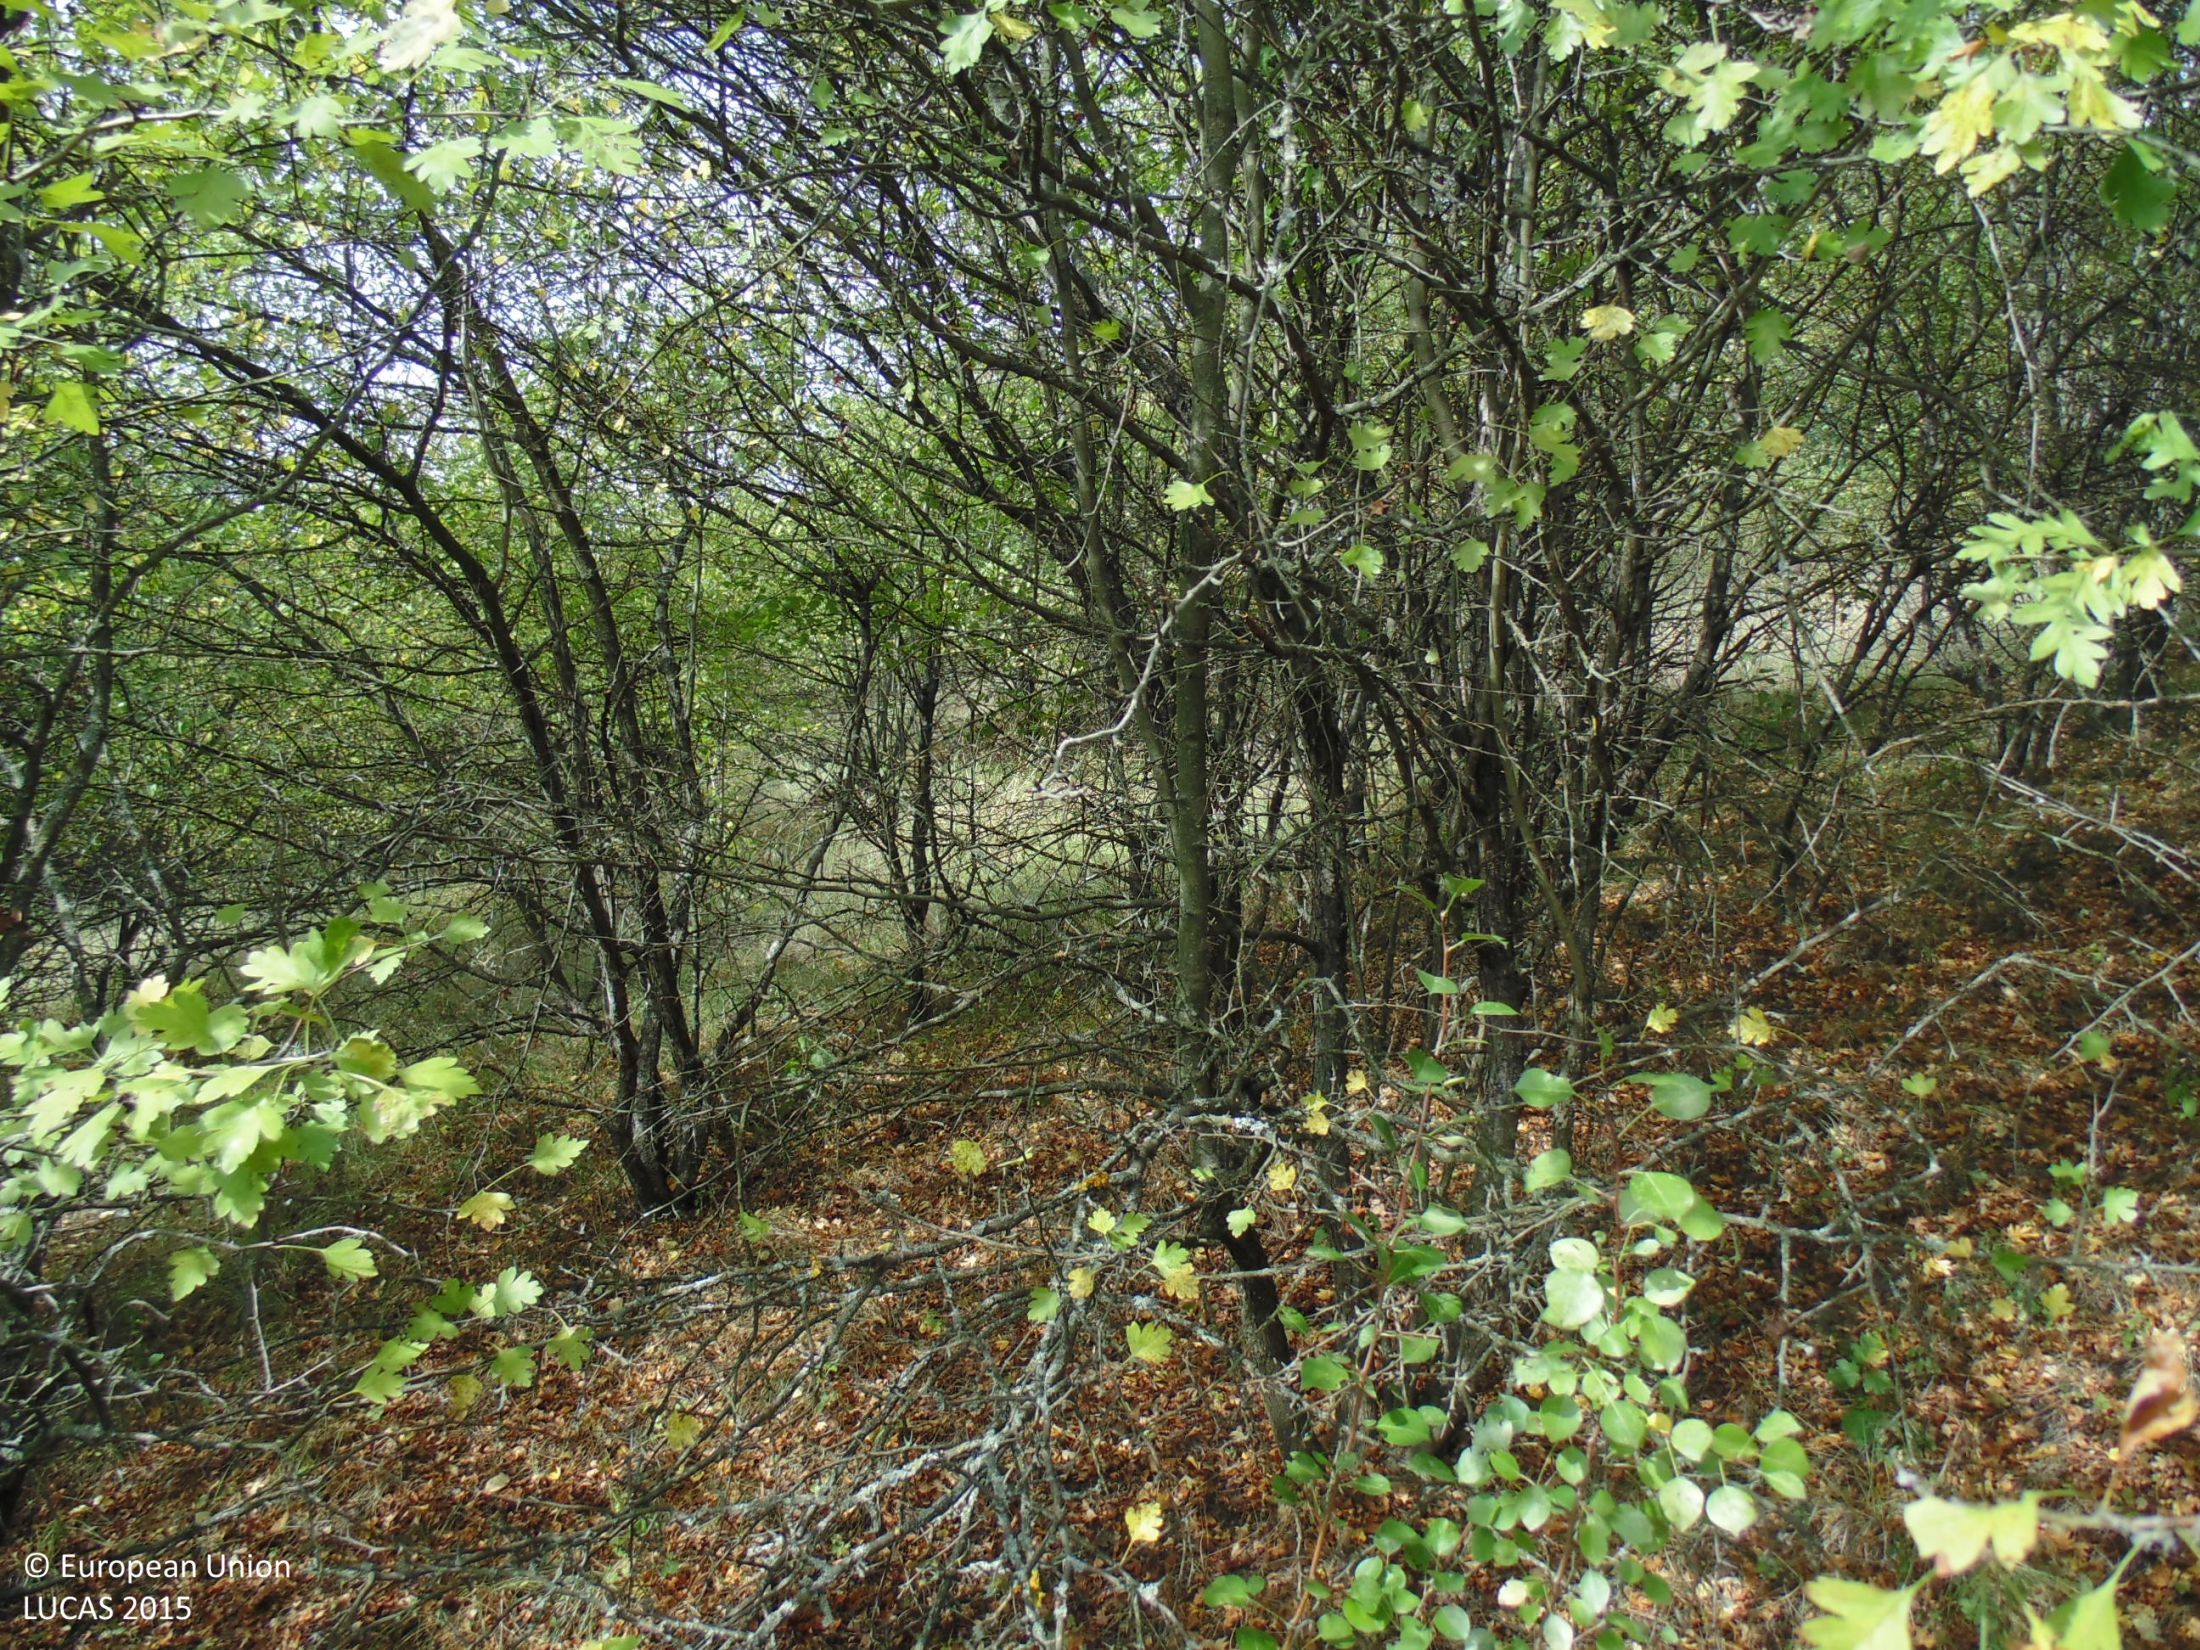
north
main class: Shrubland
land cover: Shrubland with sparse tree cover
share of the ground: 50 - 75 %
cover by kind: shrubs 65 %, herbaceous plants 30 %, broadleaved forest trees 5 %
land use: Semi-natural and natural areas not in use
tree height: < 5 m
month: September
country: BG
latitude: 43.9609
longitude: 27.1382
